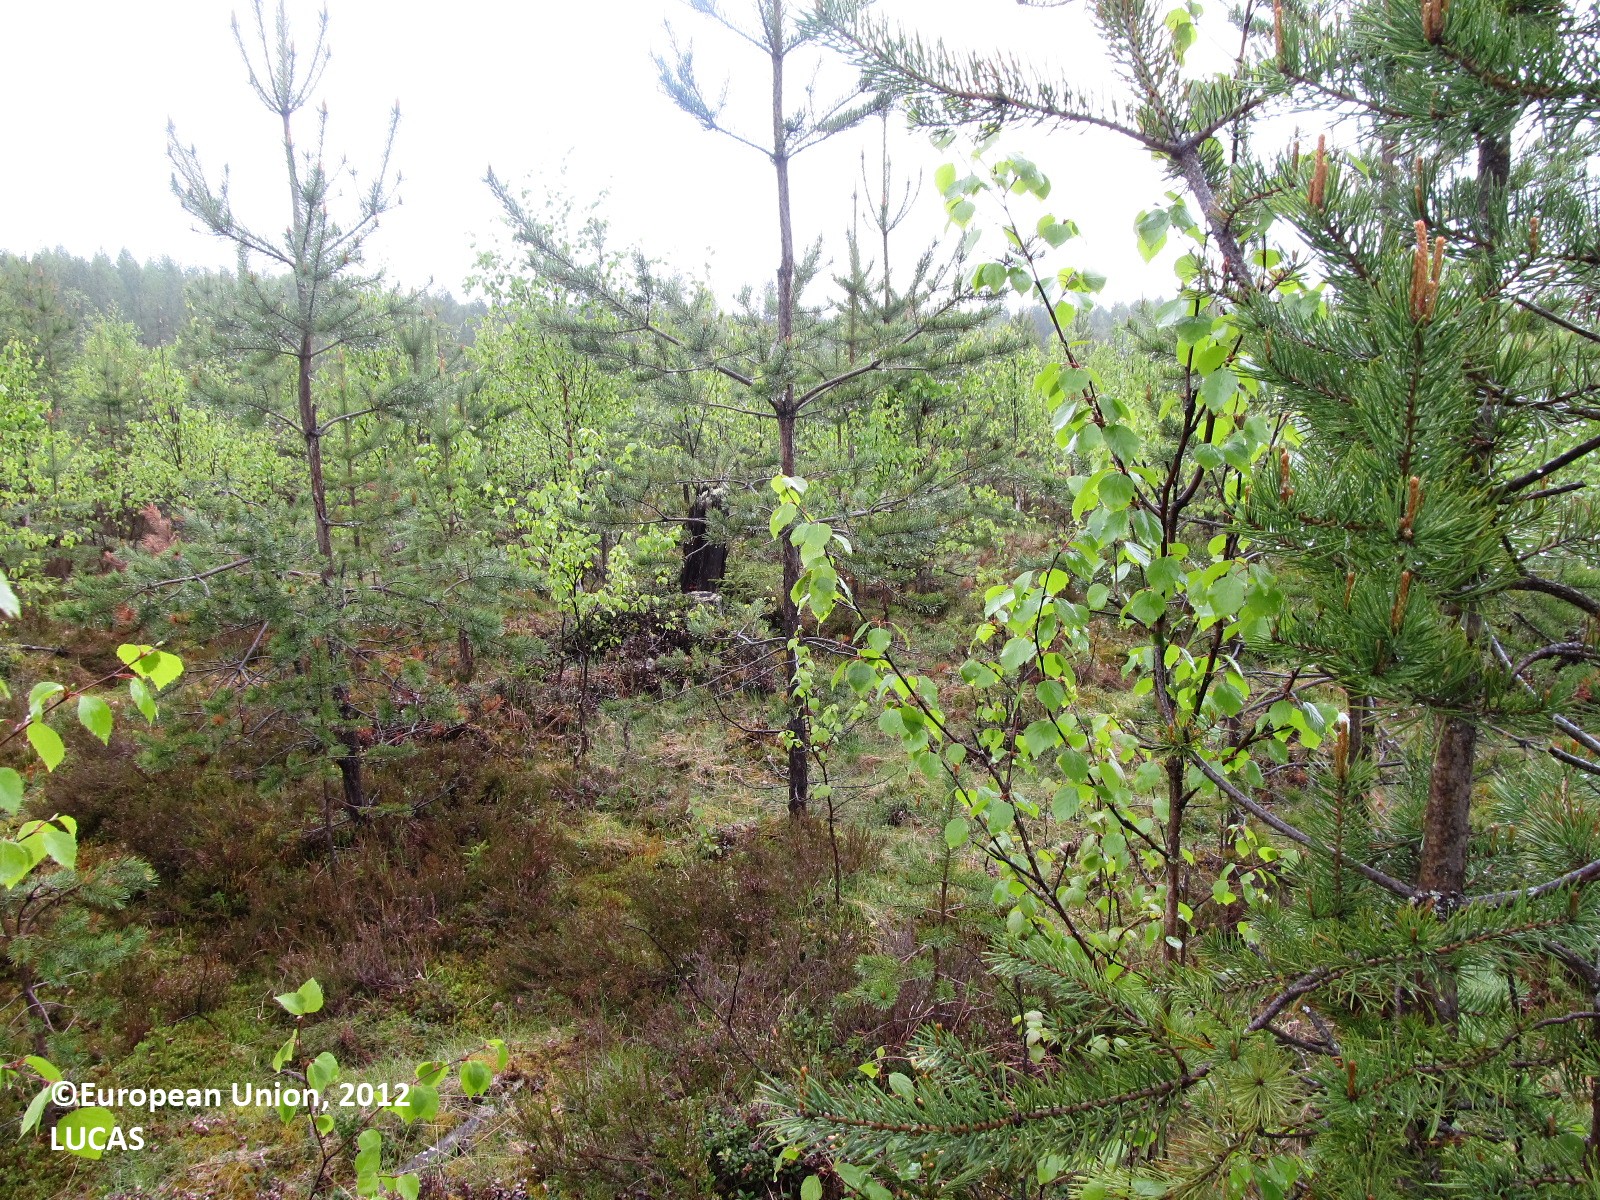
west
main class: Woodland
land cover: Pine dominated mixed woodland
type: boreal forest
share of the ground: 10 - 25 %
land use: Forestry
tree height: < 5 m
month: June
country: FI
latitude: 63.3102
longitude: 28.8220
